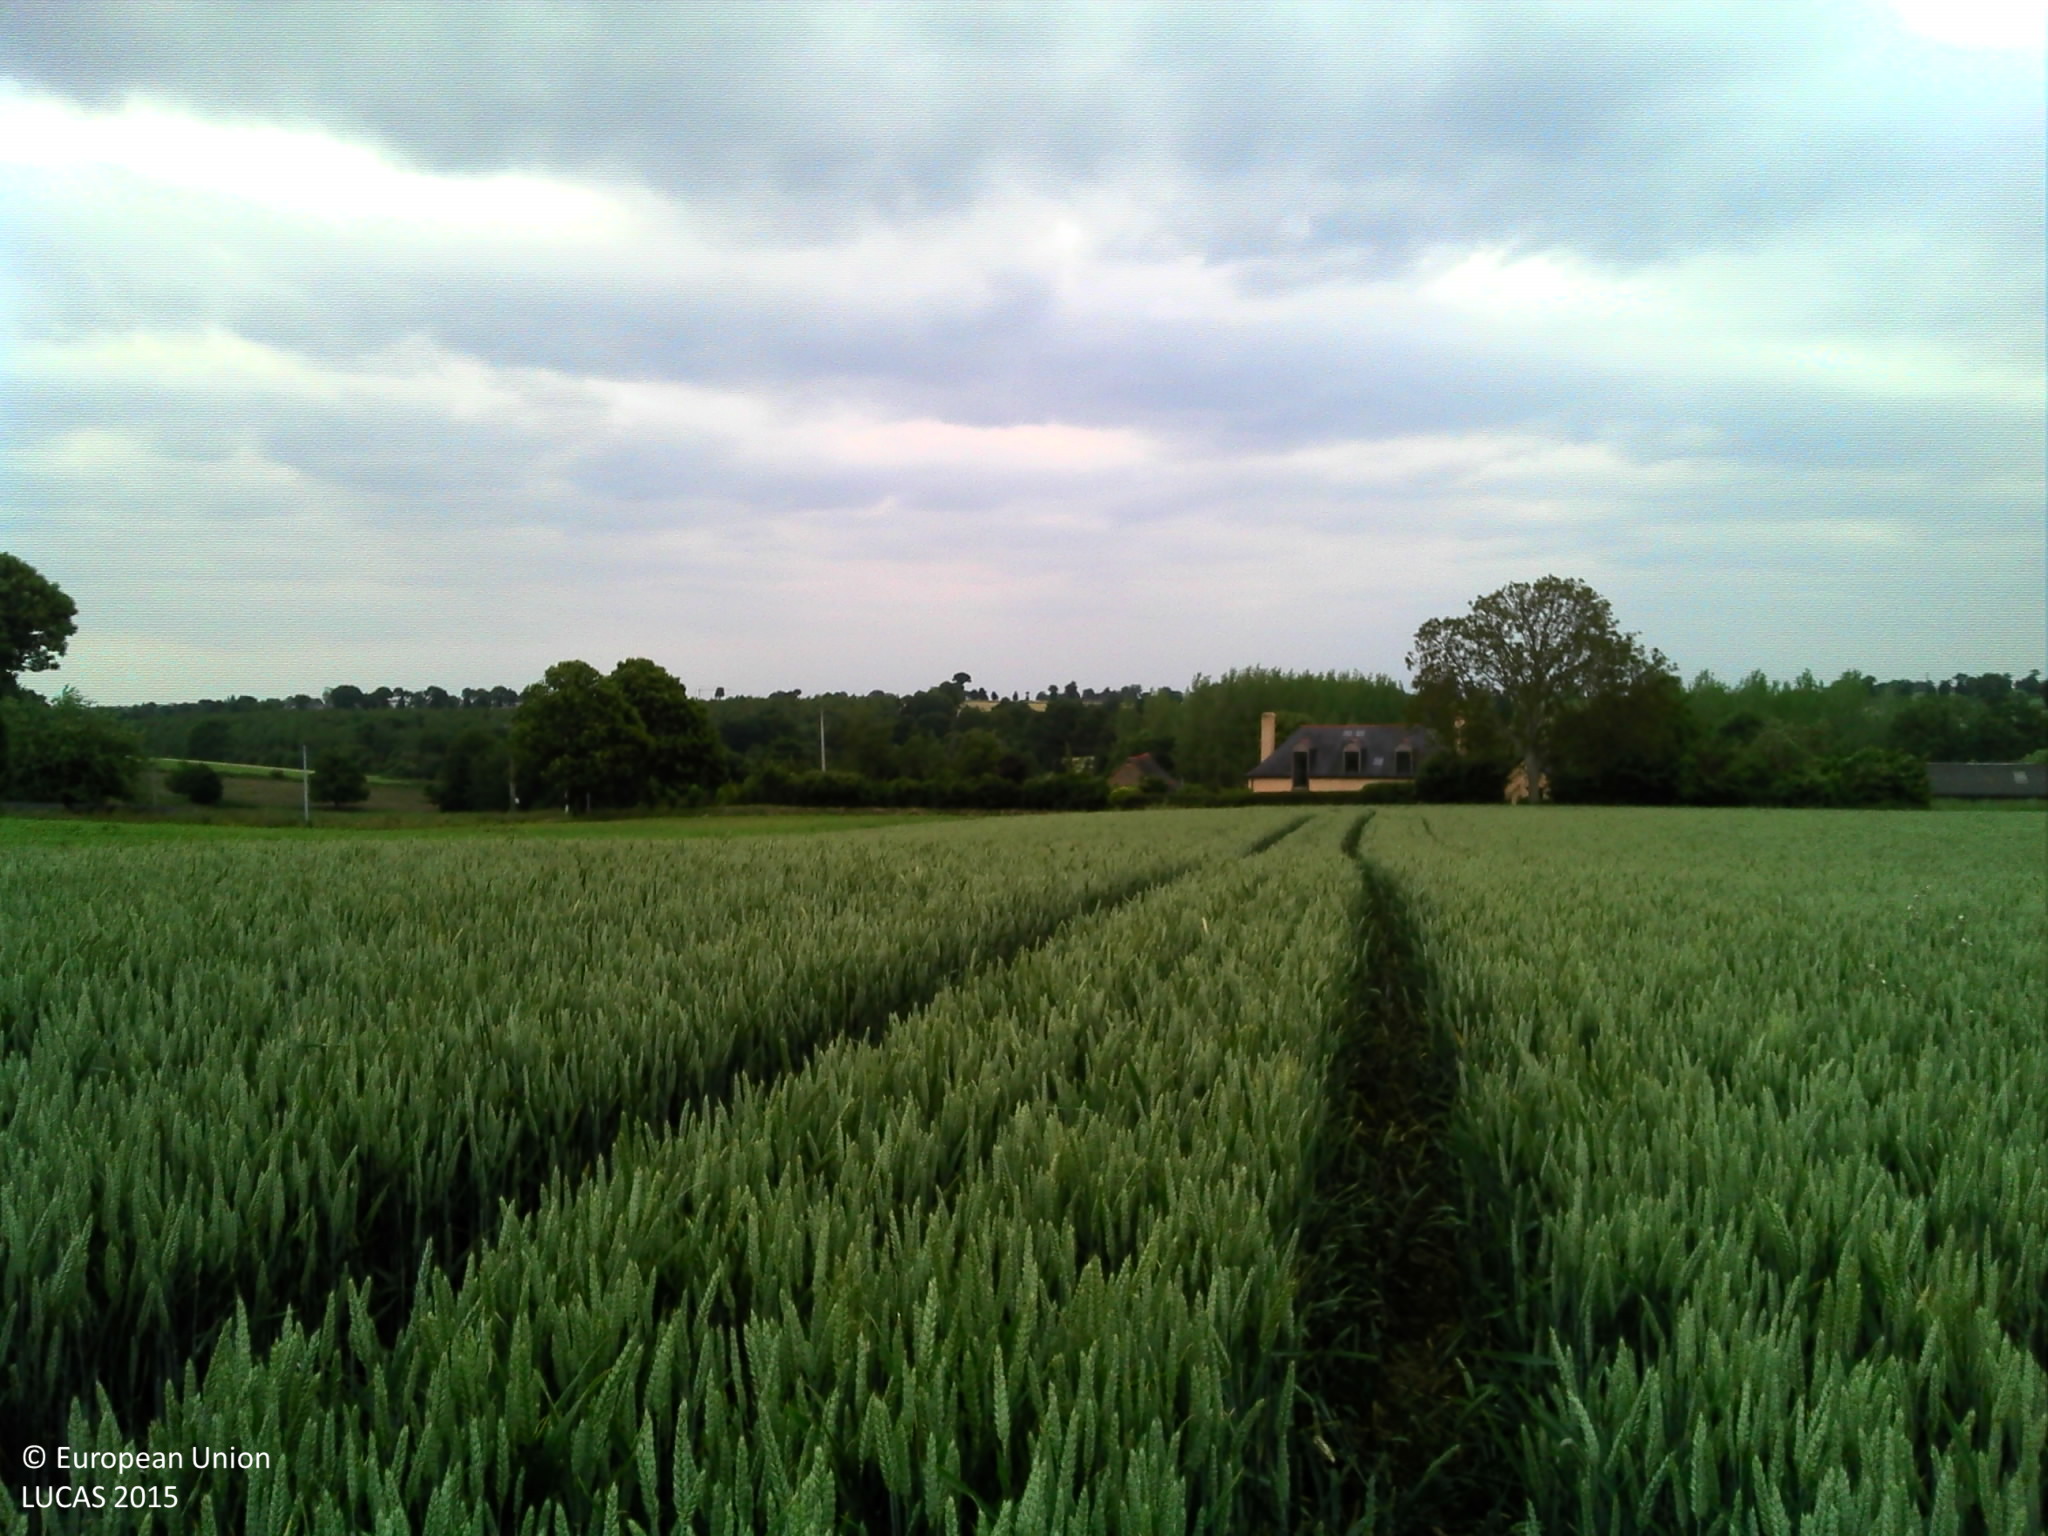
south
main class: Cropland
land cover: Common wheat
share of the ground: > 75 %
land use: Agriculture (excluding fallow land and kitchen gardens)
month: June
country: FR
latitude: 48.2023
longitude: -1.6599
